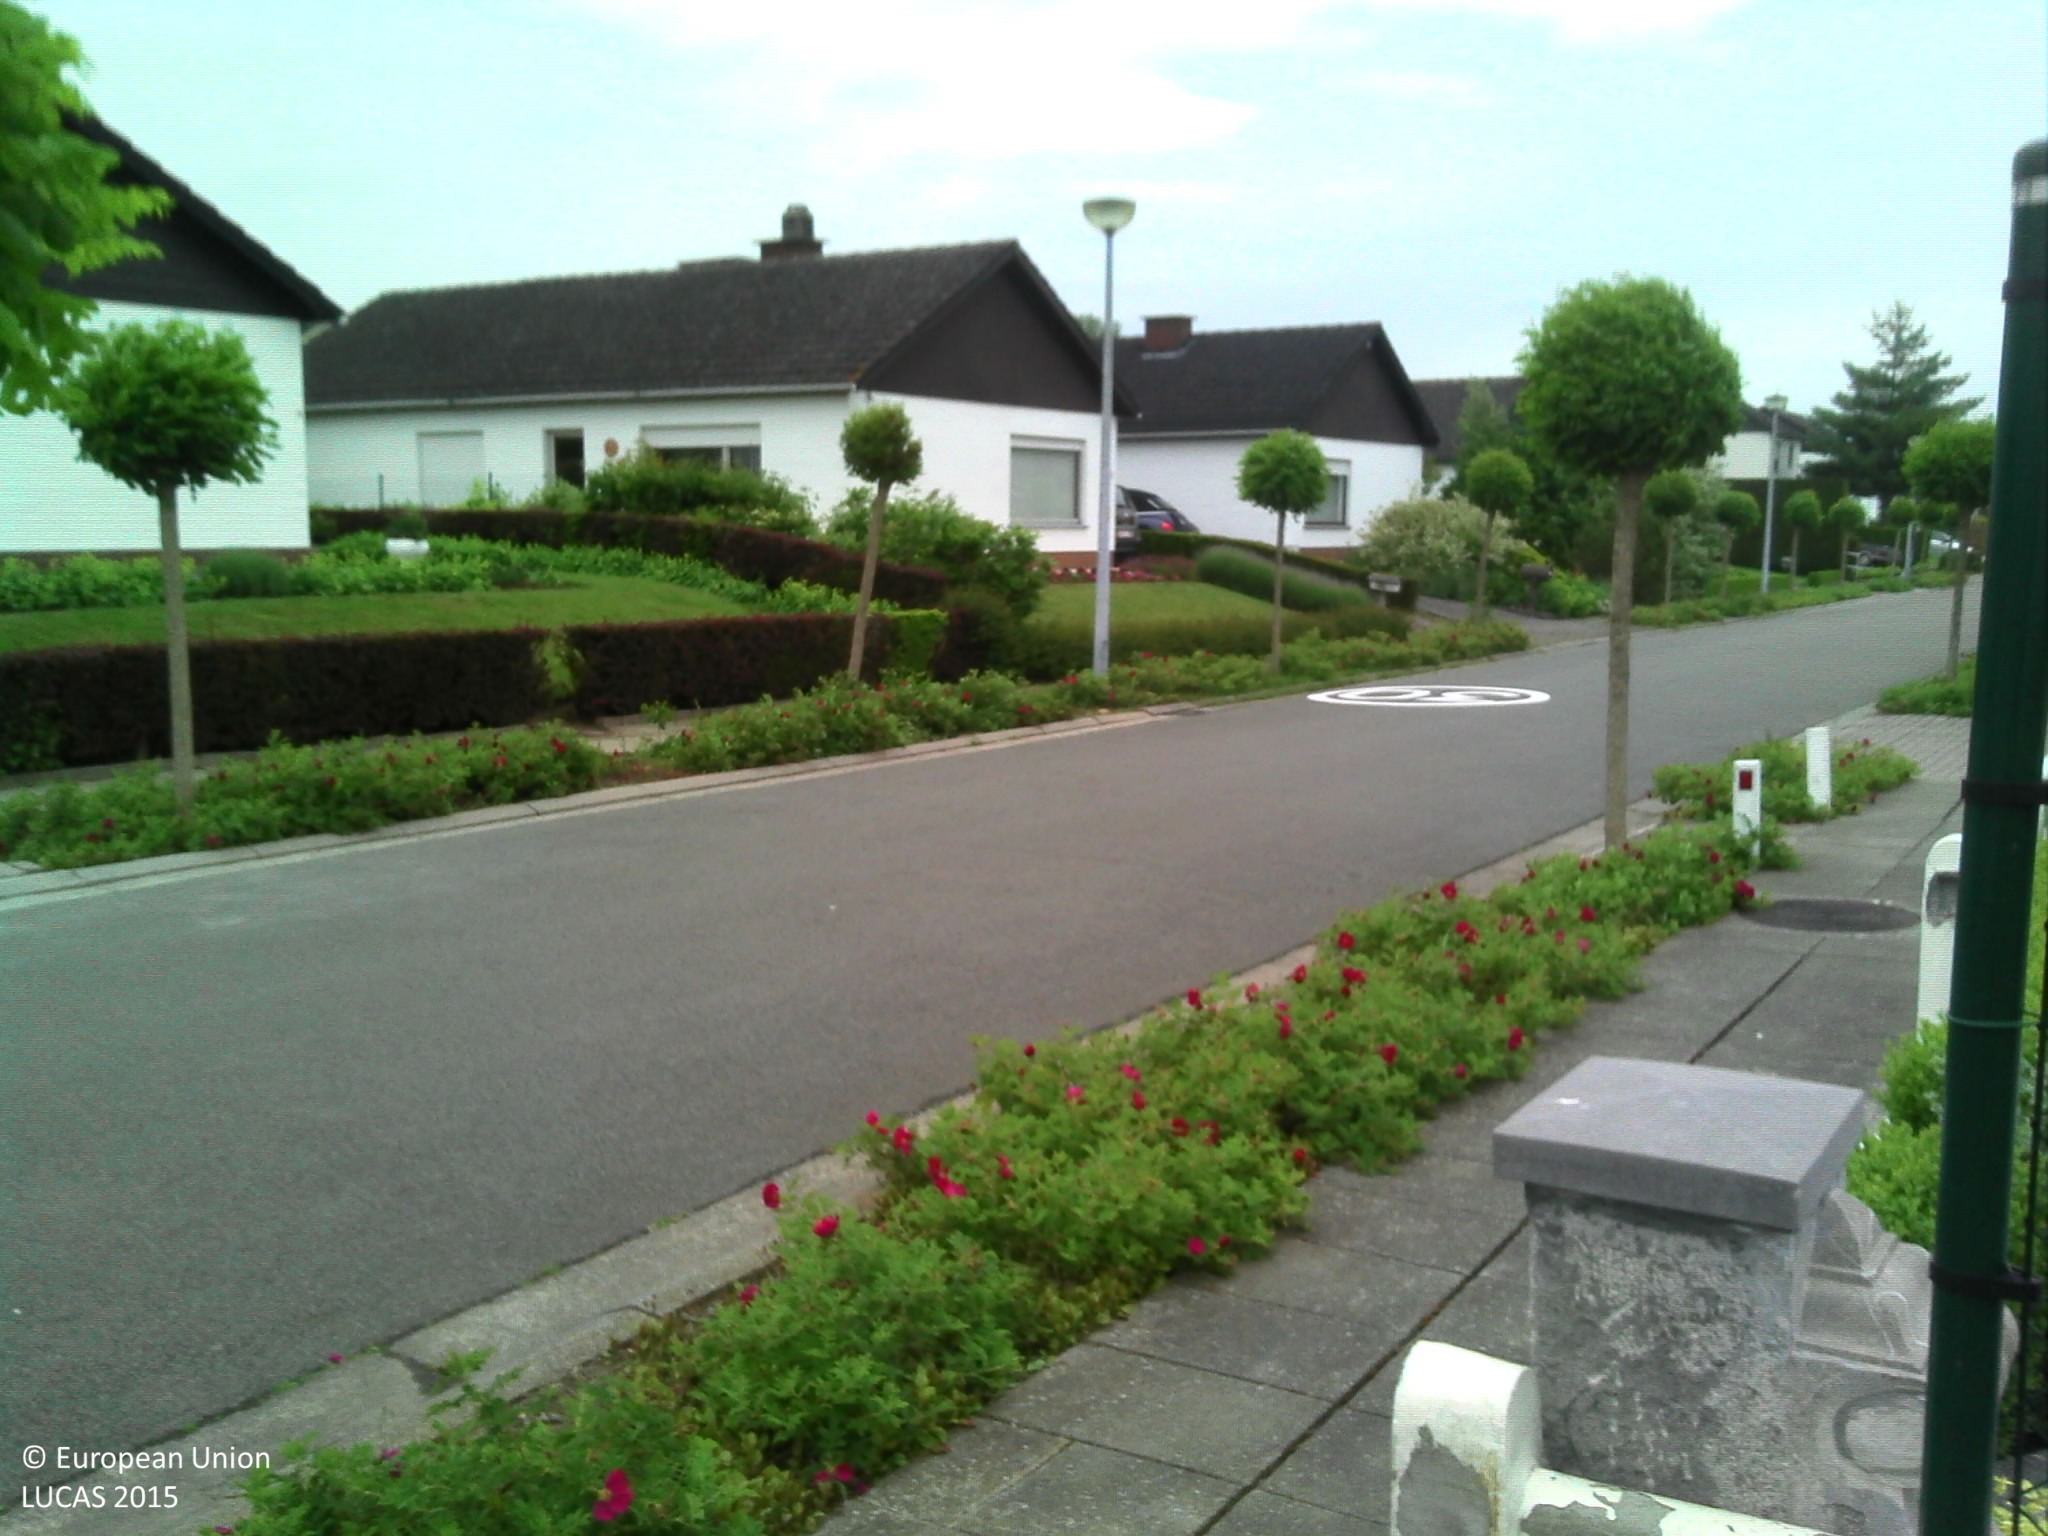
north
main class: Grassland
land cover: Grassland without tree/shrub cover
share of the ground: > 75 %
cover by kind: herbaceous plants 100 %
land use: Residential
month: June
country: BE
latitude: 50.8071
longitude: 3.7635
